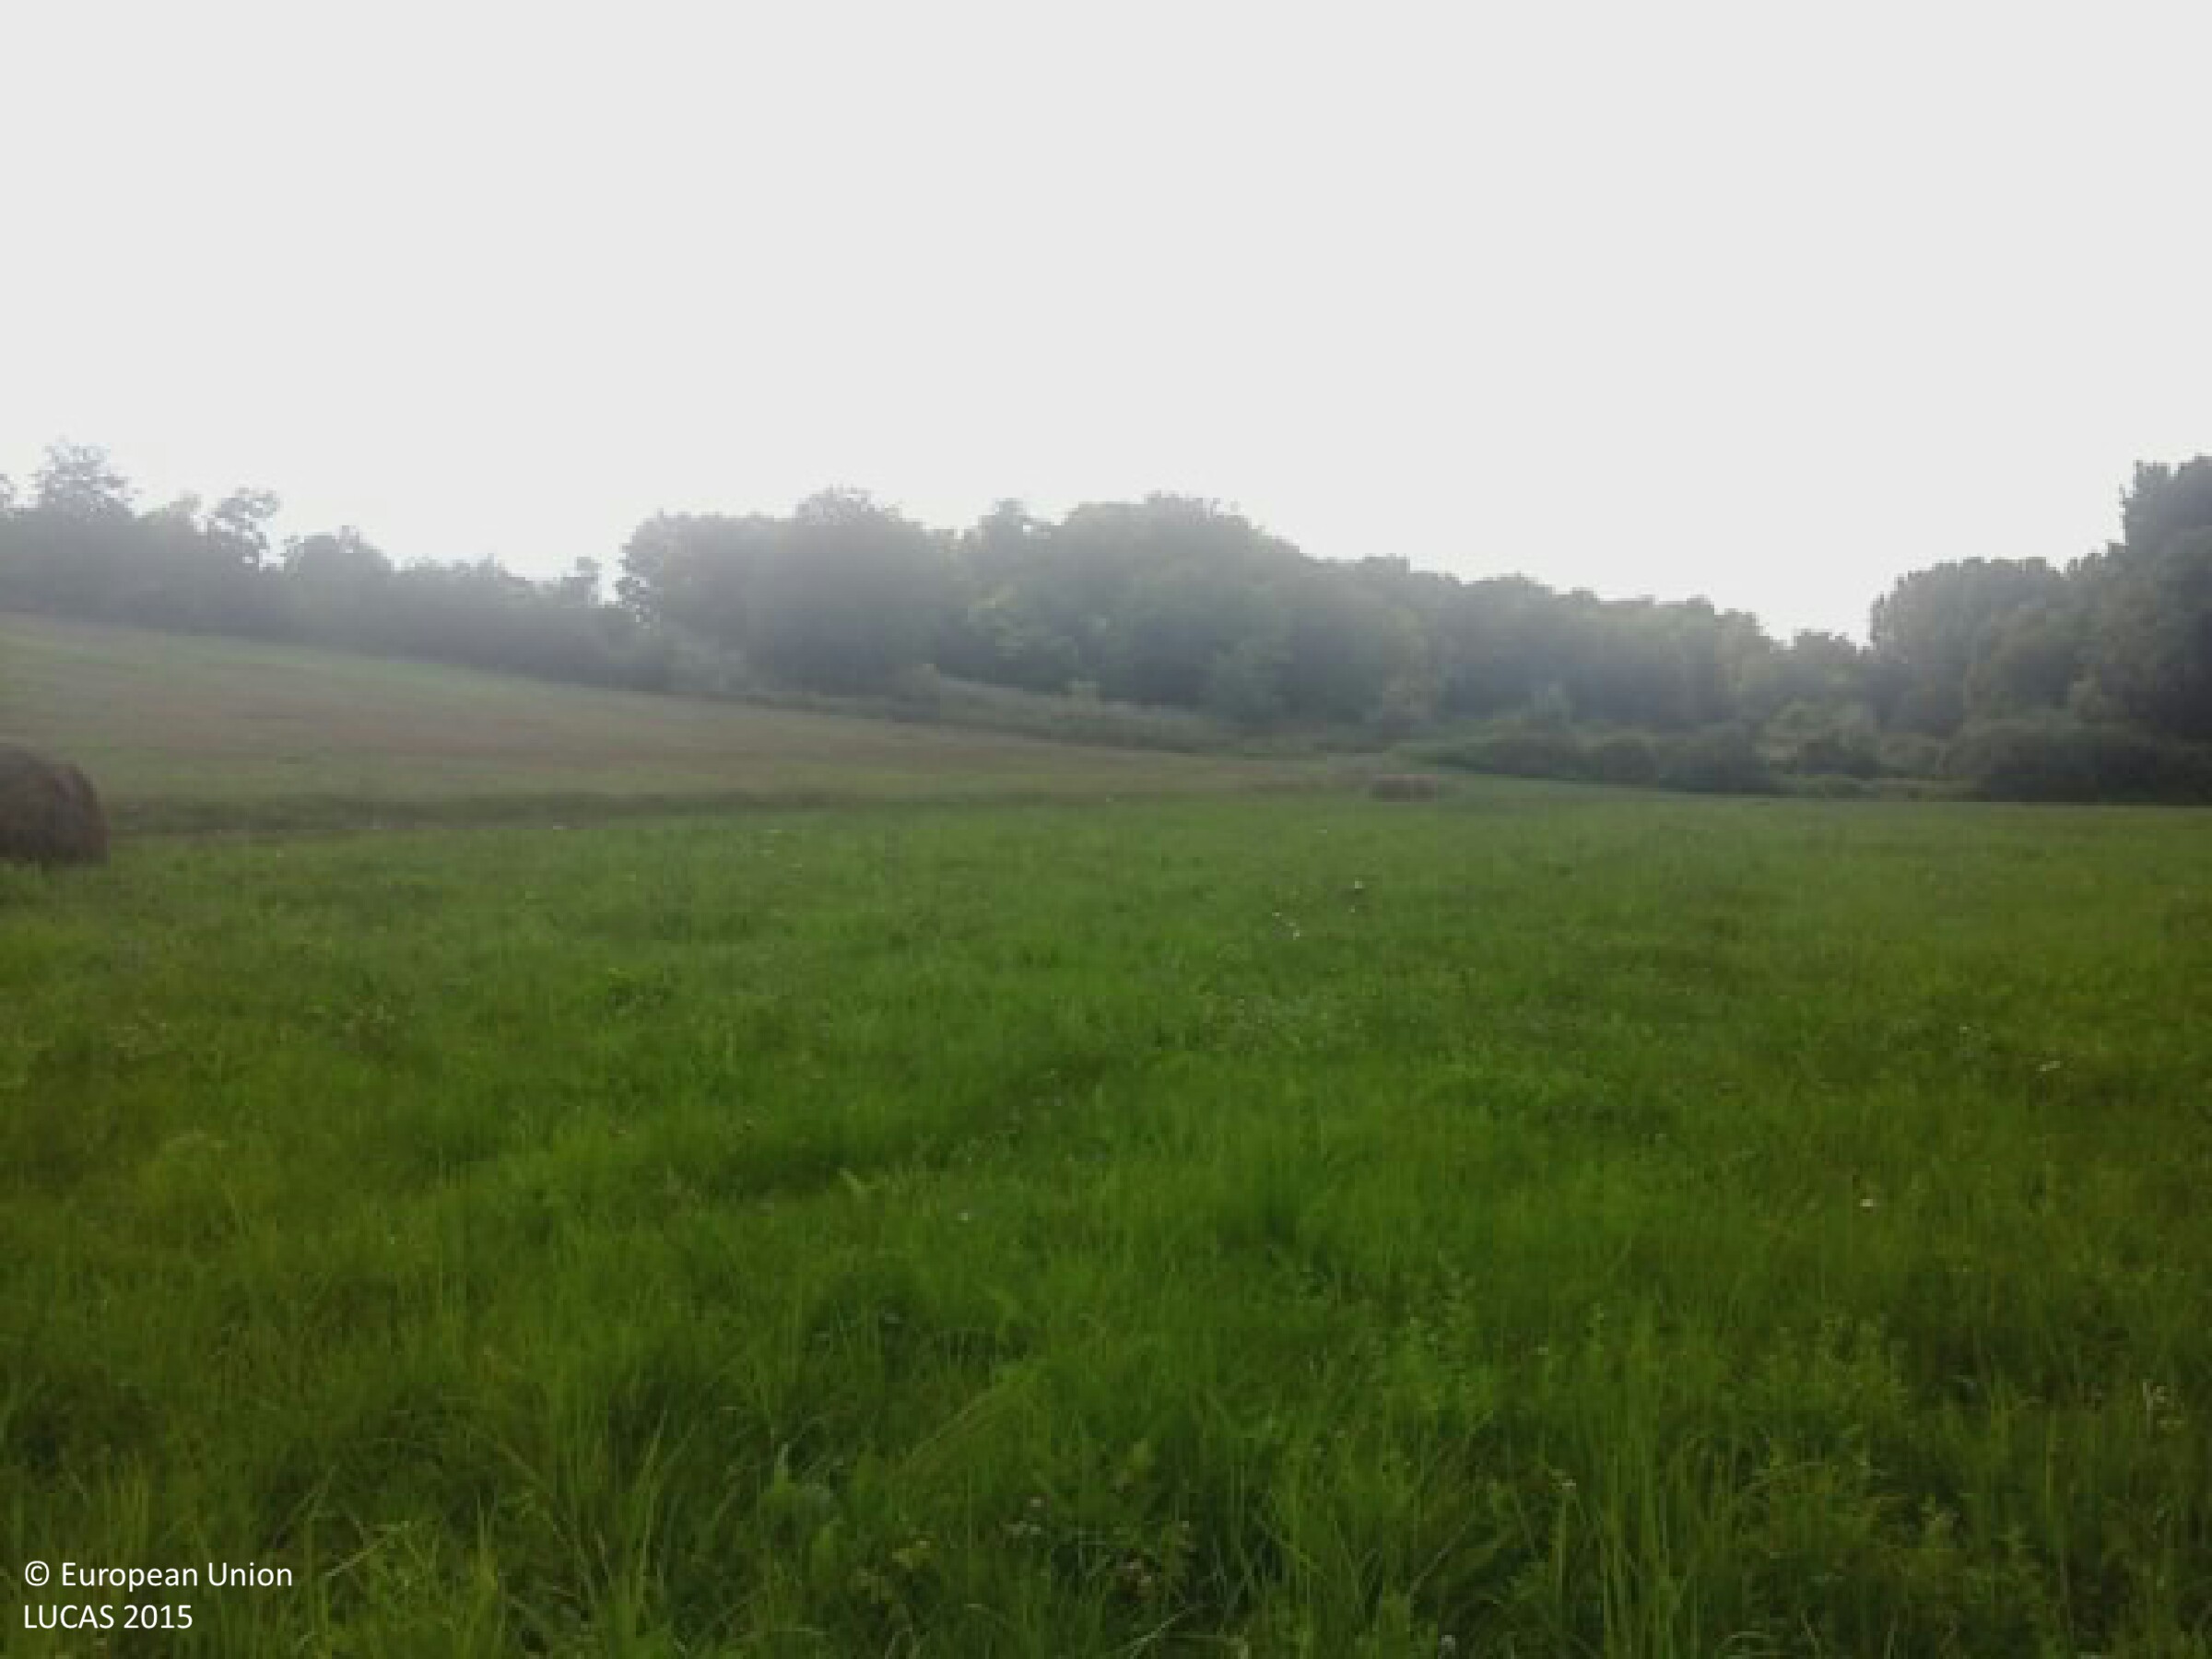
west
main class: Grassland
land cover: Grassland without tree/shrub cover
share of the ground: > 75 %
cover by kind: herbaceous plants 100 %
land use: Agriculture (excluding fallow land and kitchen gardens)
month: August
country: HU
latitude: 46.3092
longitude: 18.4103
